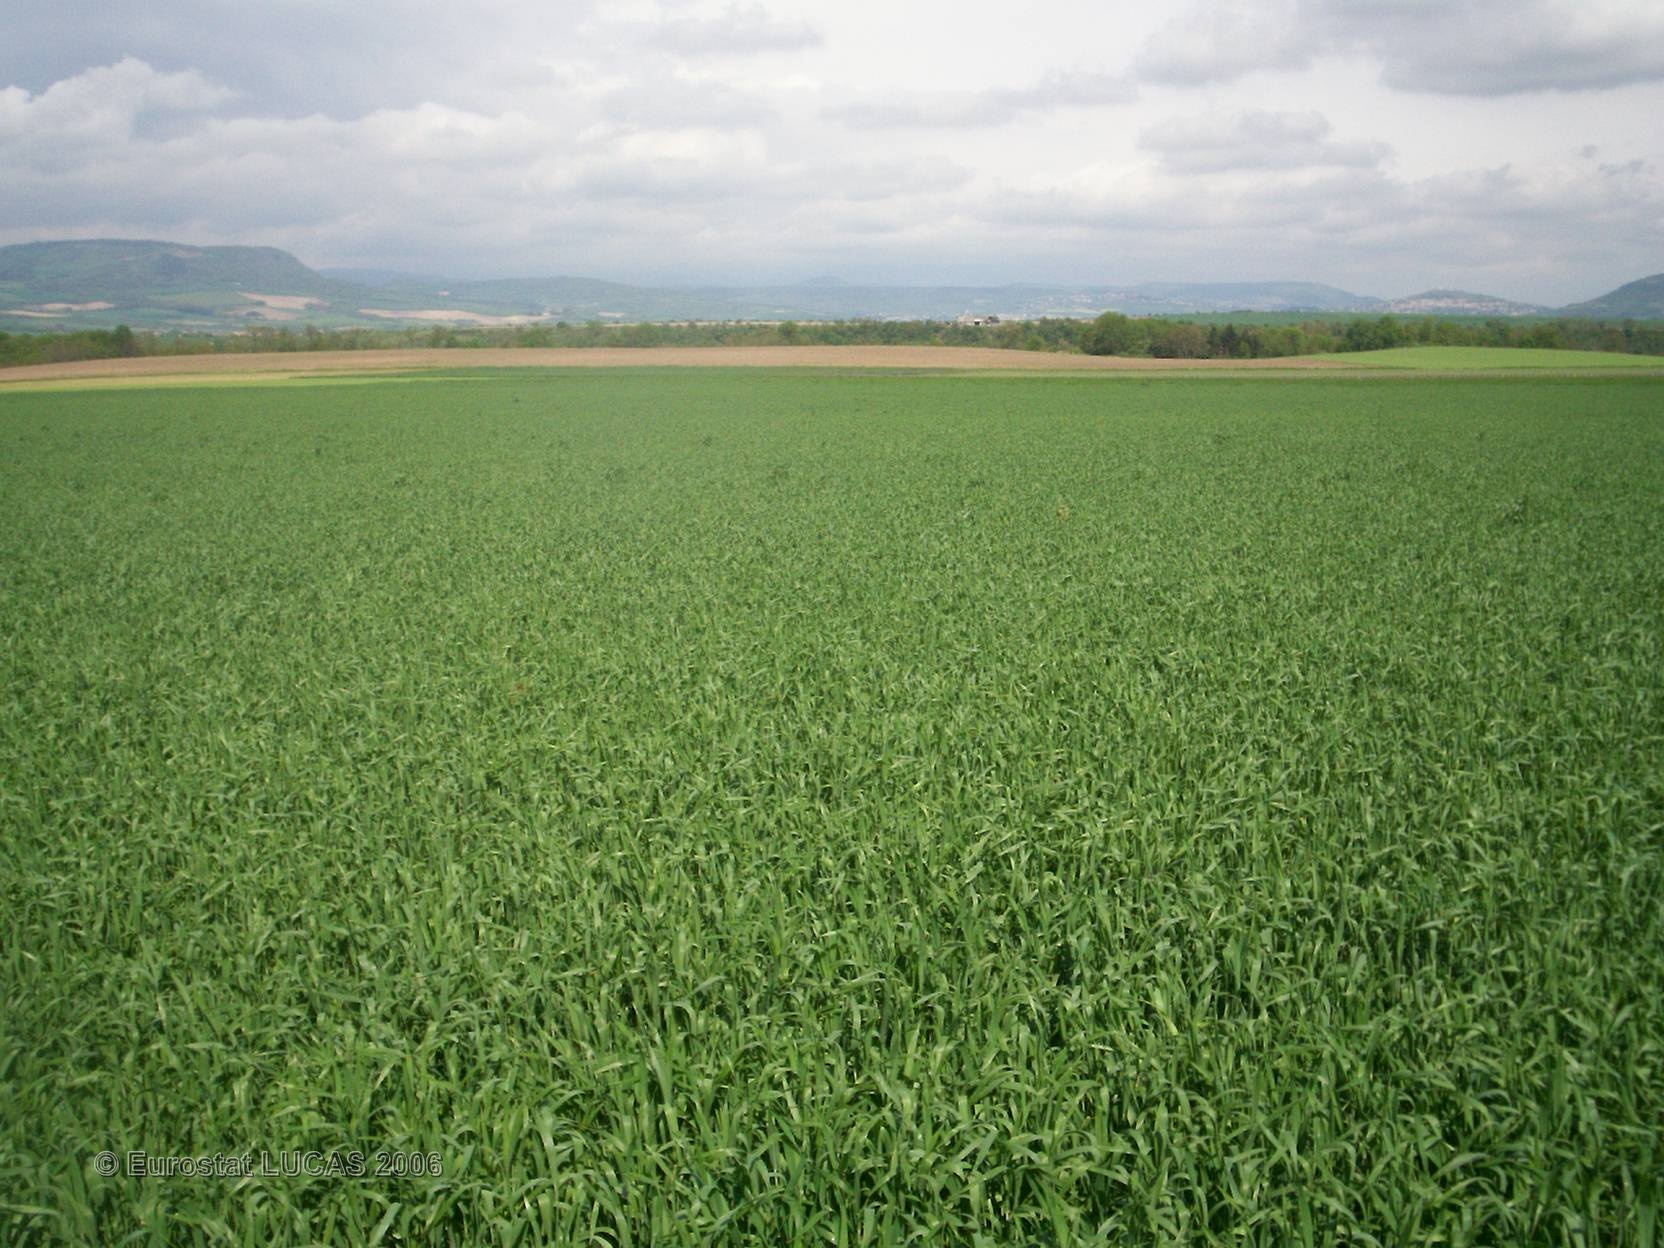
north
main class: Cropland
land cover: Common wheat
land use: Agriculture (excluding fallow land and kitchen gardens)
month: May
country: FR
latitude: 45.5921
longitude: 3.1940
